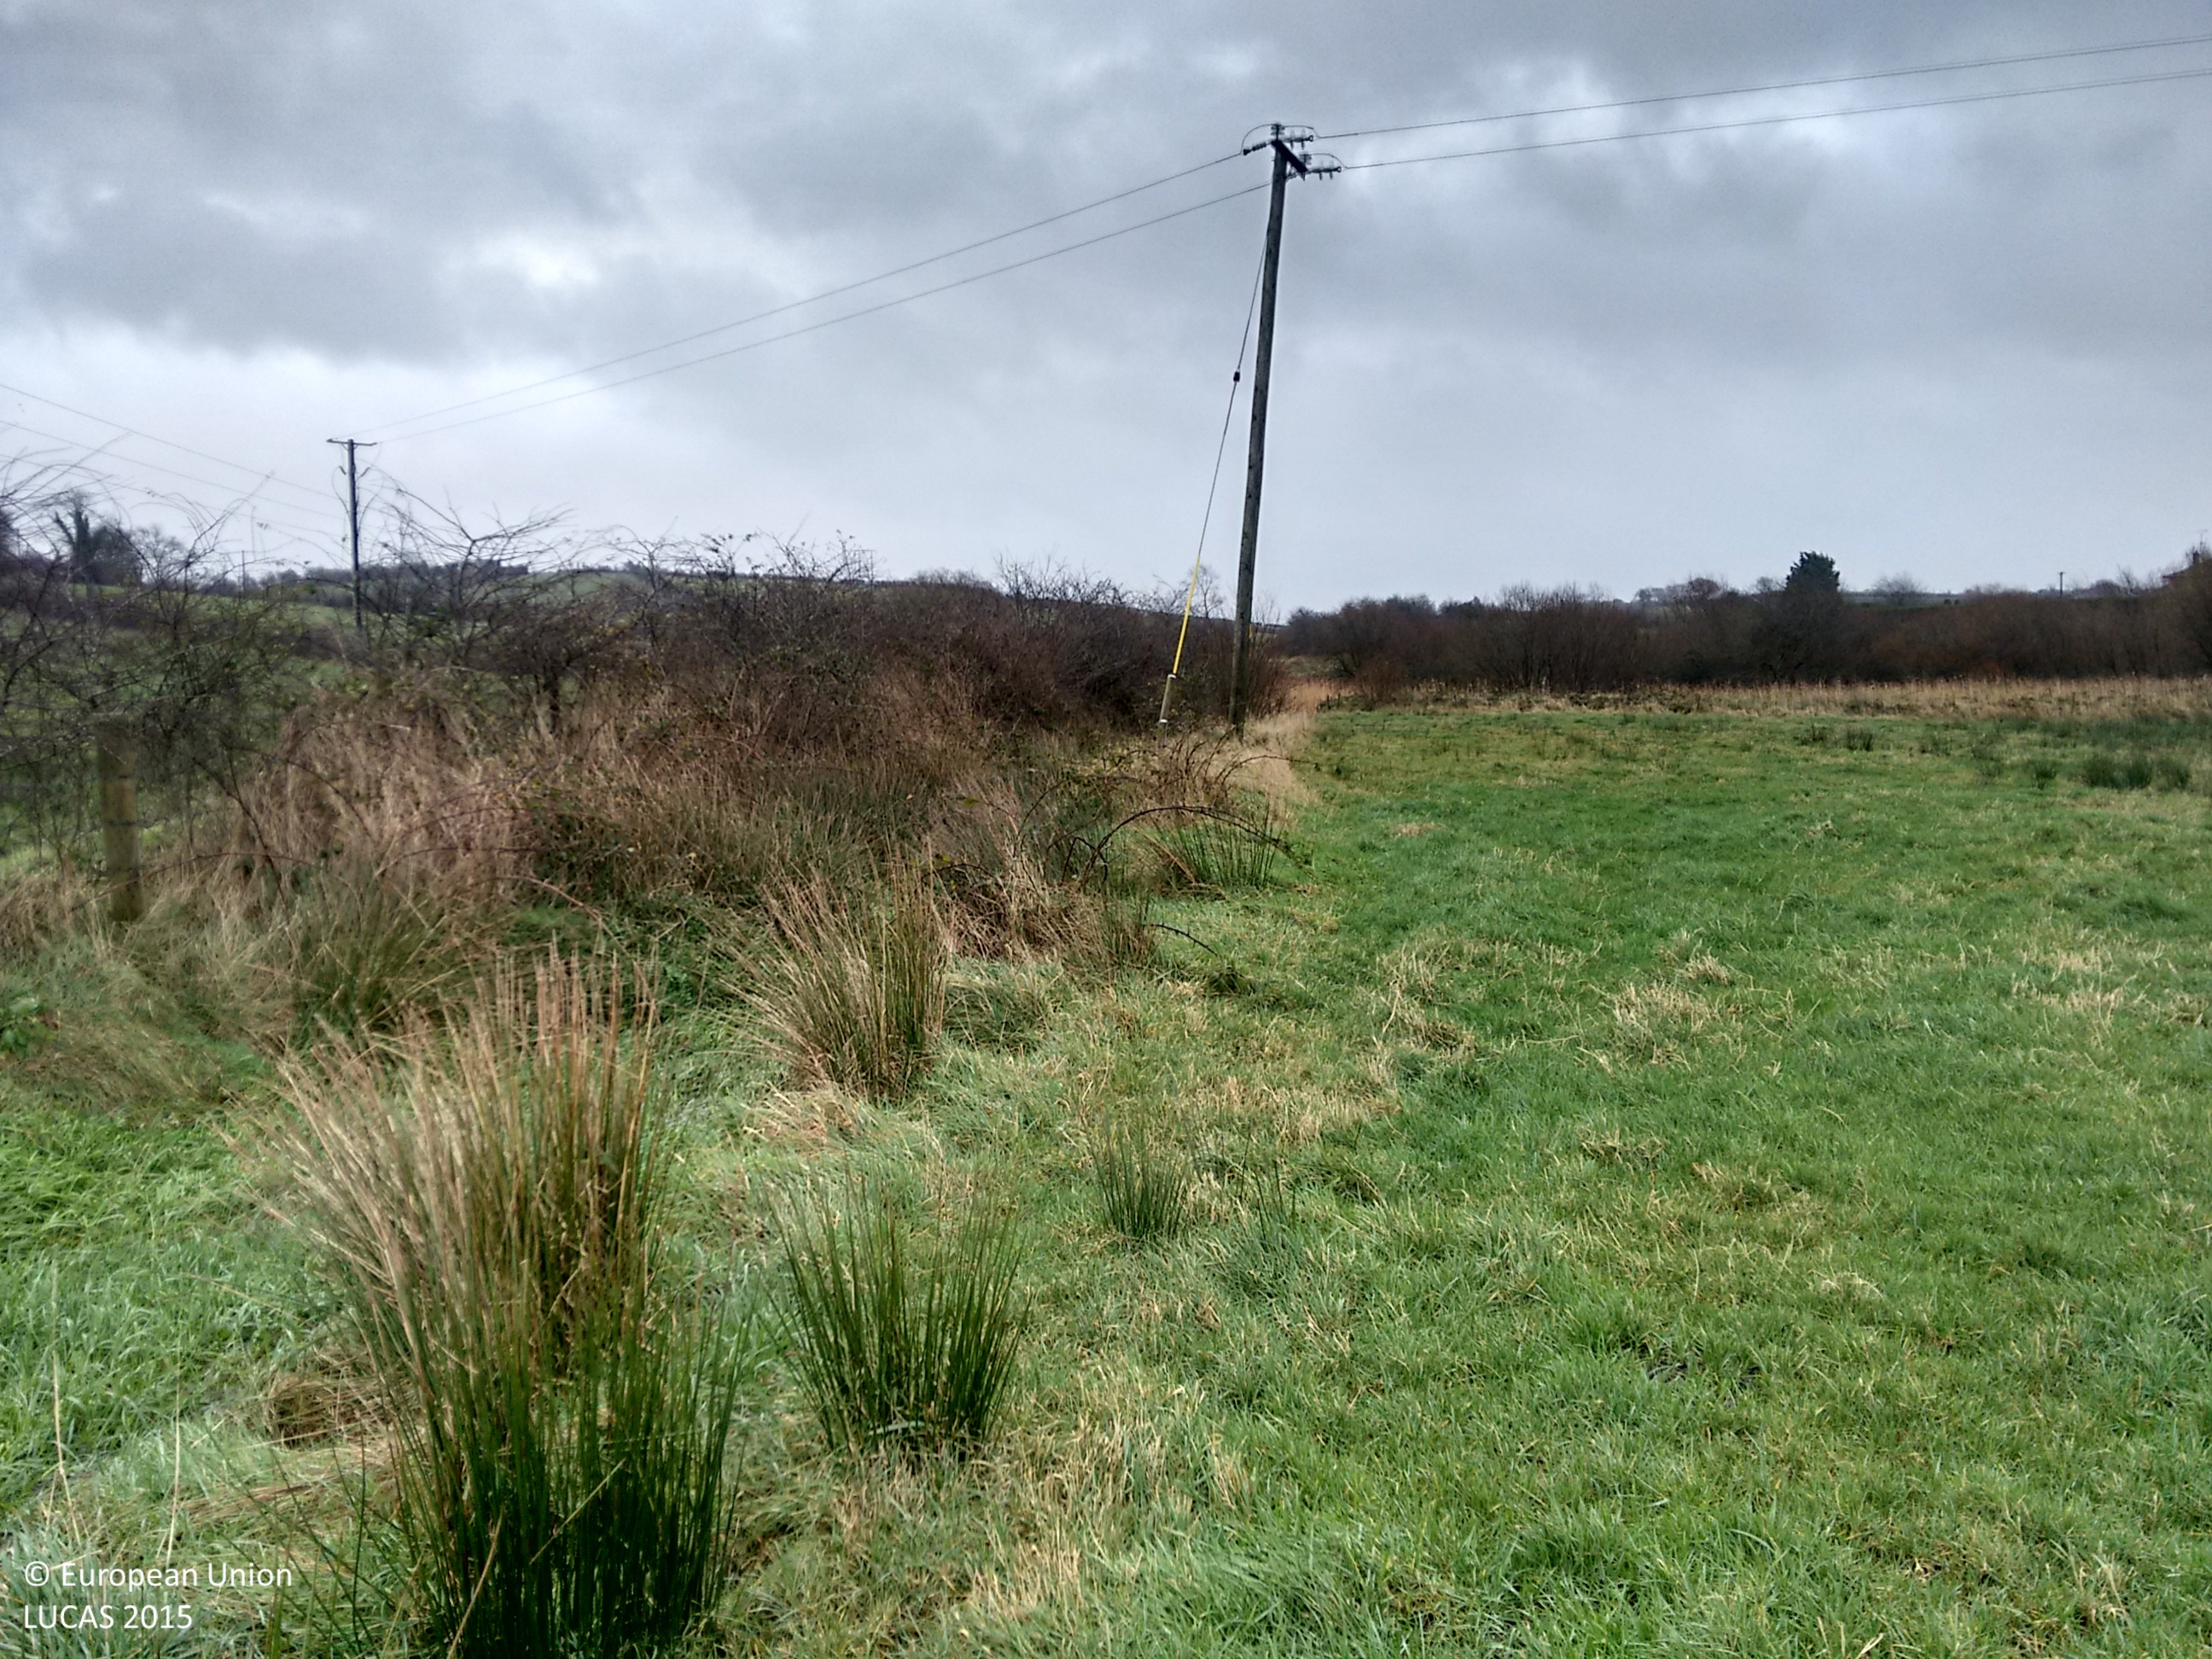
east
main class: Grassland
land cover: Grassland without tree/shrub cover
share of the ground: > 75 %
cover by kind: herbaceous plants 100 %
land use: Agriculture (excluding fallow land and kitchen gardens)
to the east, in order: Grassland without tree/shrub cover; Rivers and streams; Abandoned hedges; Electric lines; Fences; Grassland without tree/shrub cover; Fences; Abandoned hedges; Inland marshes; Inland fresh water bodies; Inland marshes; Grassland without tree/shrub cover
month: December
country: IE
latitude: 54.0212
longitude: -6.9126
